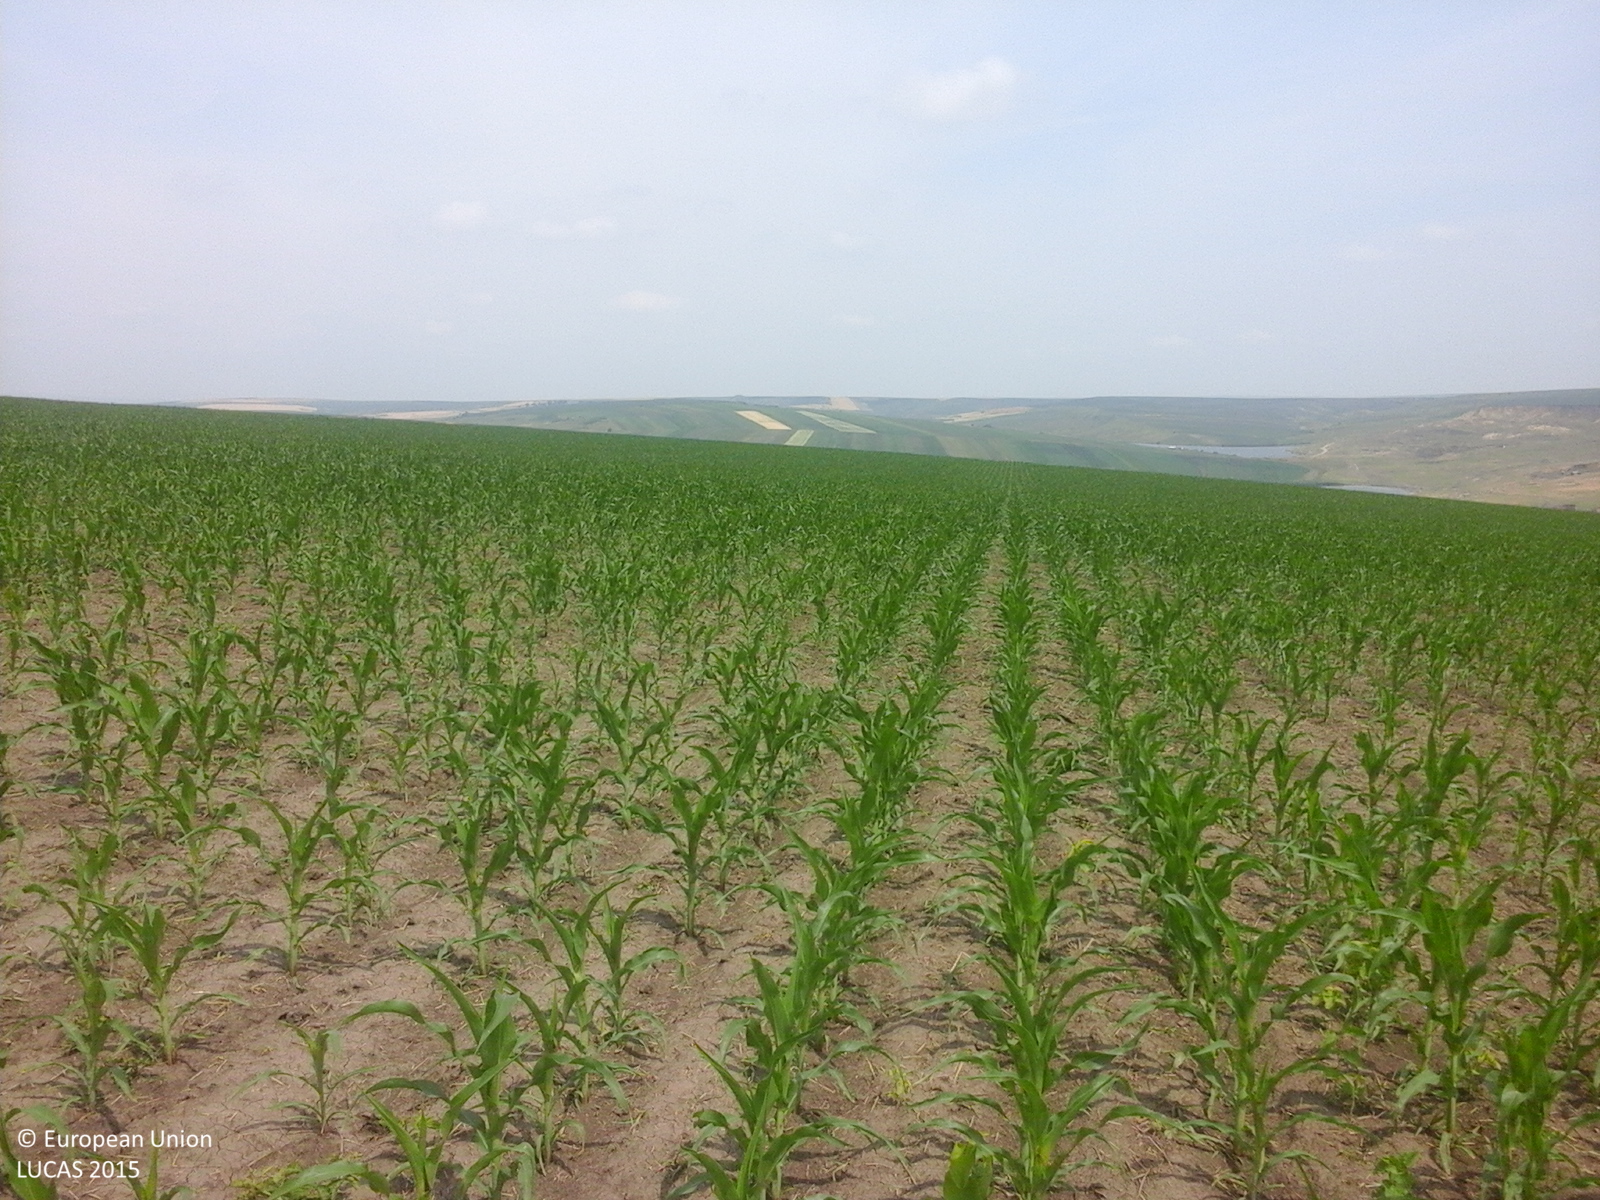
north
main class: Cropland
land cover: Maize
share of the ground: 50 - 75 %
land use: Agriculture (excluding fallow land and kitchen gardens)
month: June
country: RO
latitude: 47.4011
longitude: 27.0239
